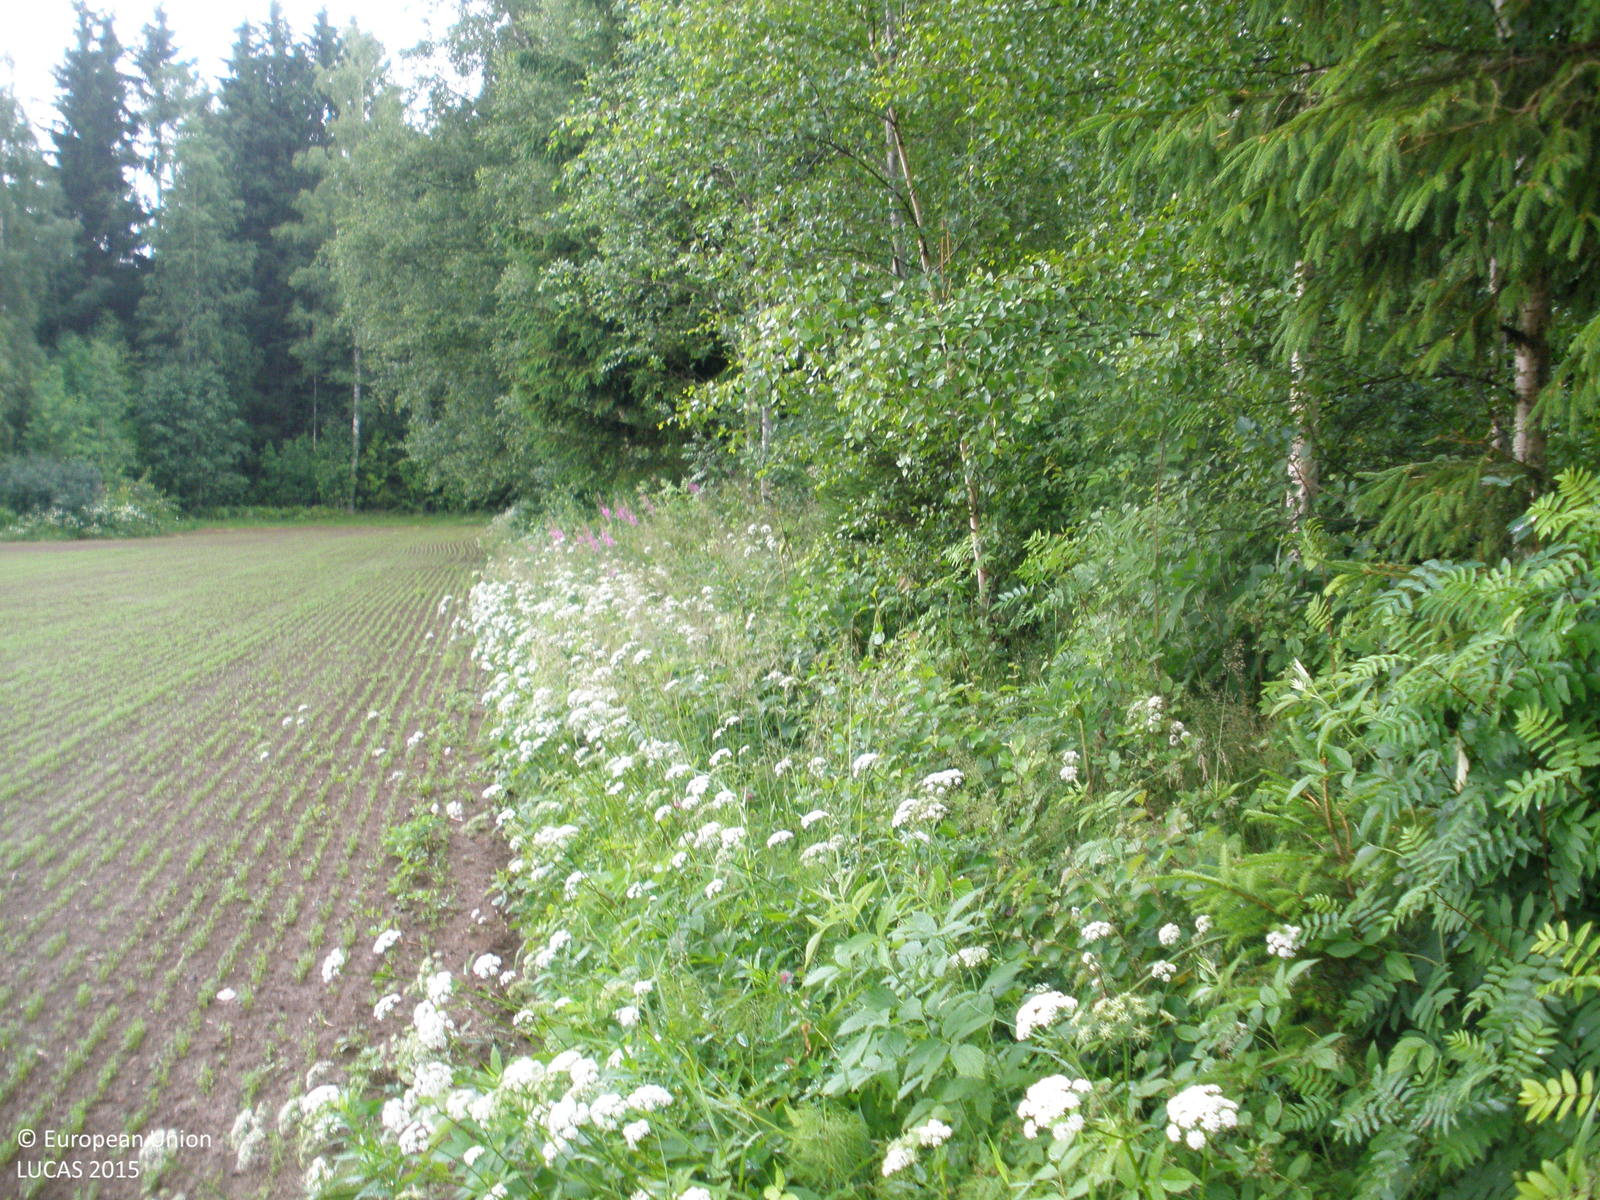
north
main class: Cropland
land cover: Other root crops
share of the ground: 25 - 50 %
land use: Agriculture (excluding fallow land and kitchen gardens)
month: July
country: FI
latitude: 61.4590
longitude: 23.9914
